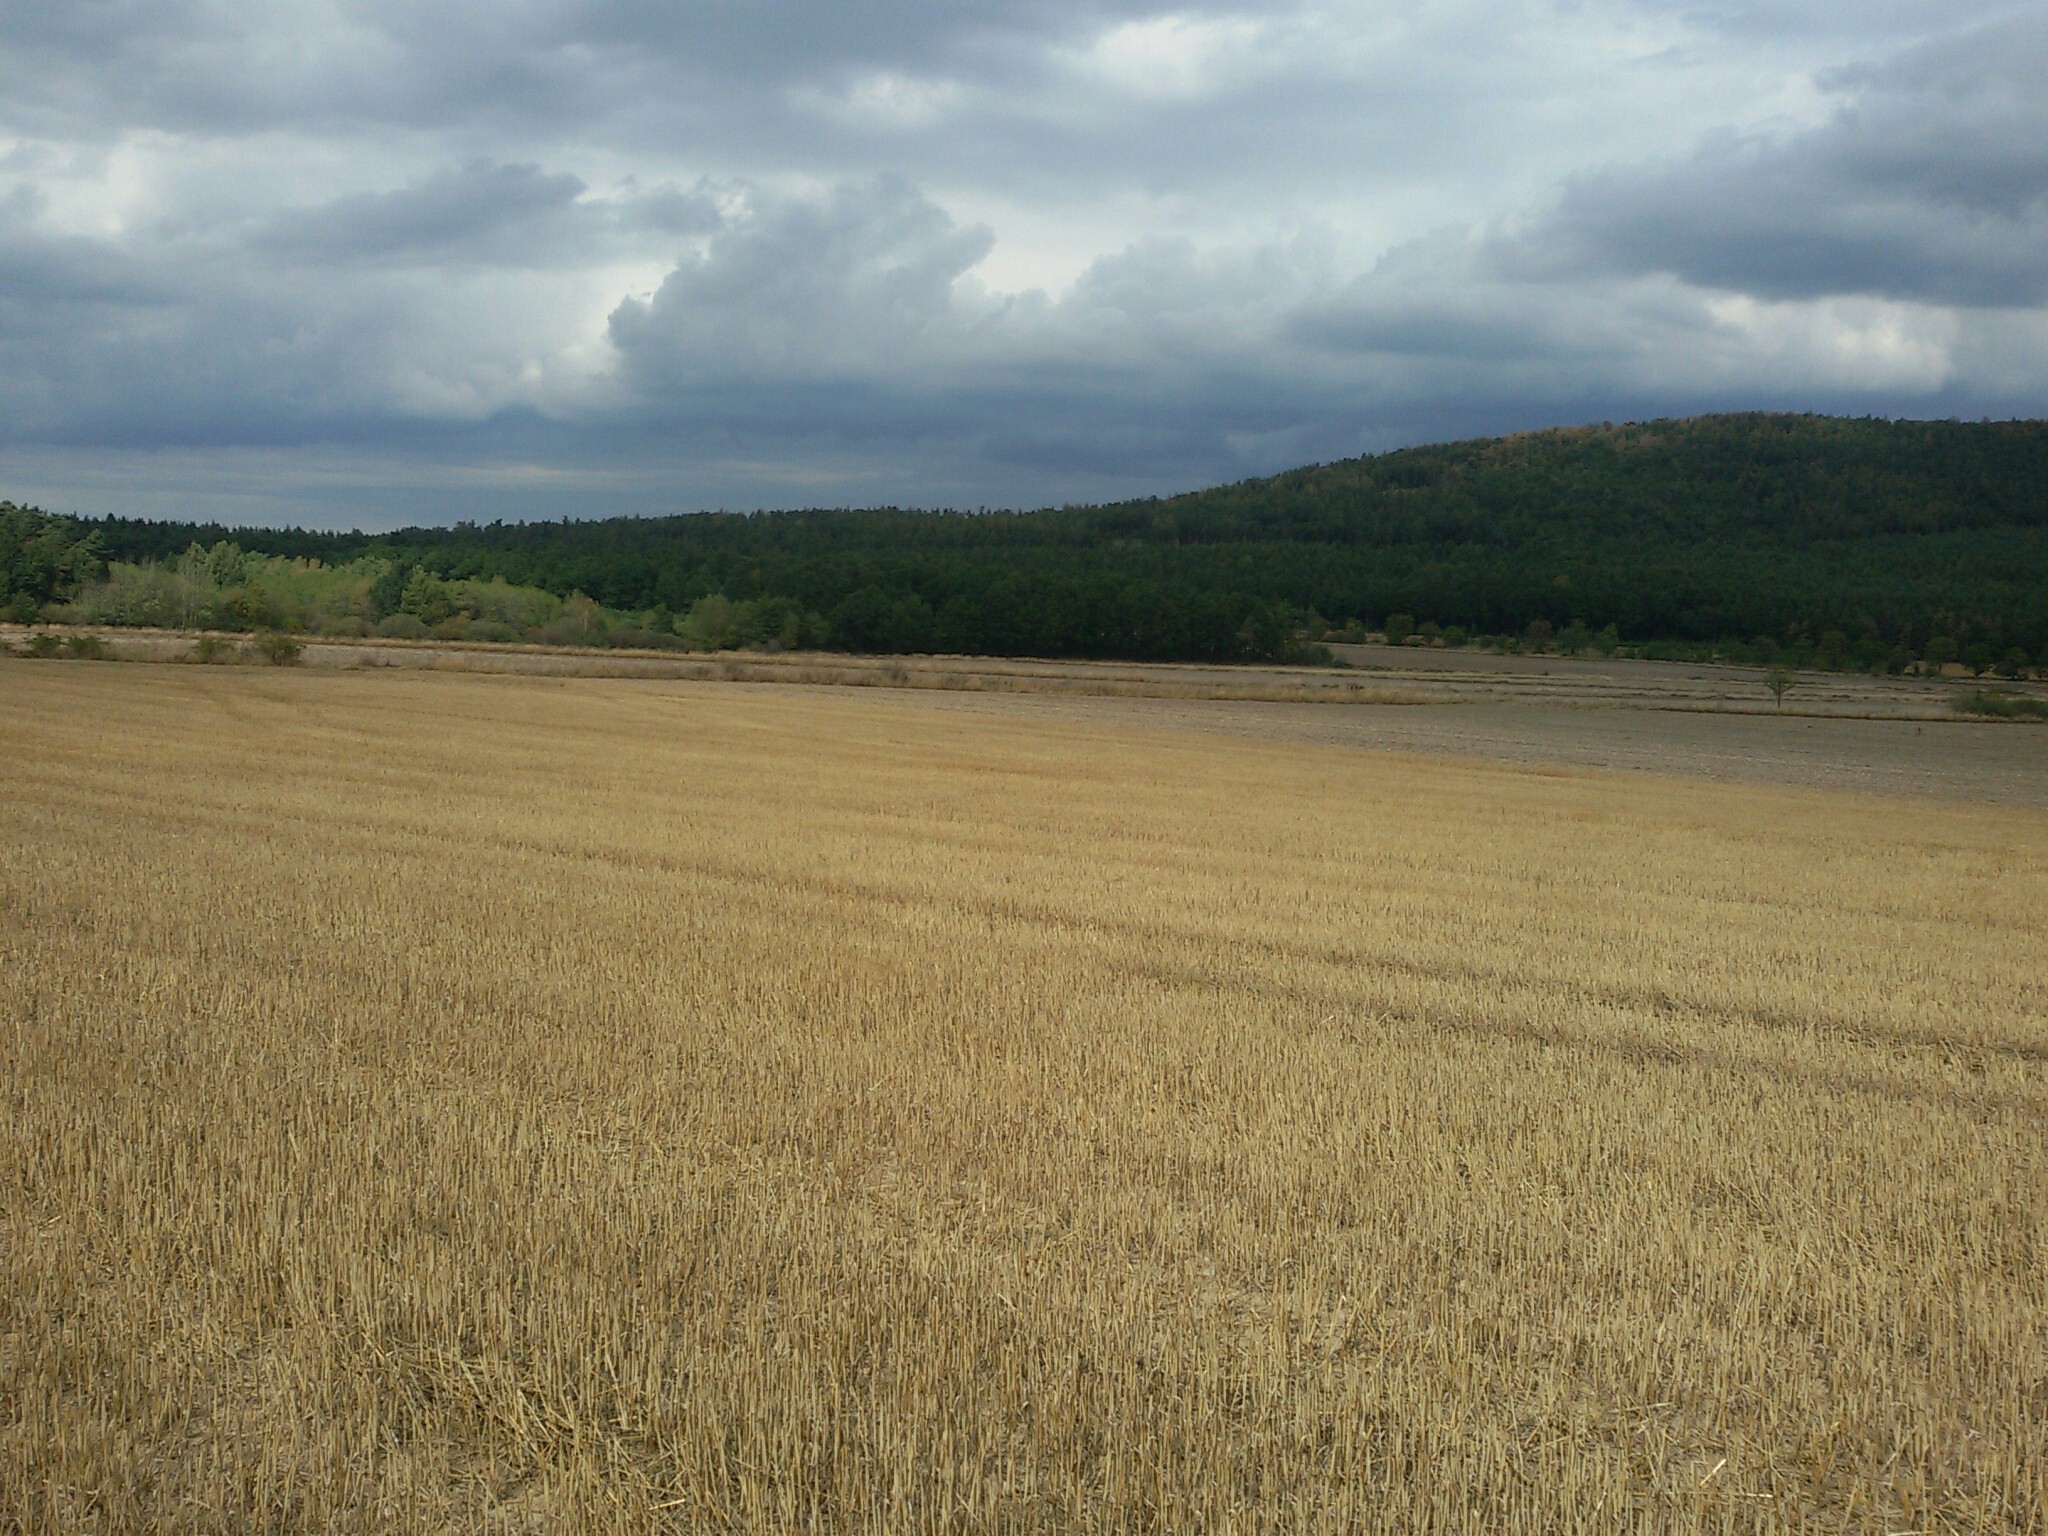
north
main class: Cropland
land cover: Common wheat
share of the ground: > 75 %
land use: Agriculture (excluding fallow land and kitchen gardens)
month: September
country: PL
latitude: 50.5458
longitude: 16.7119
